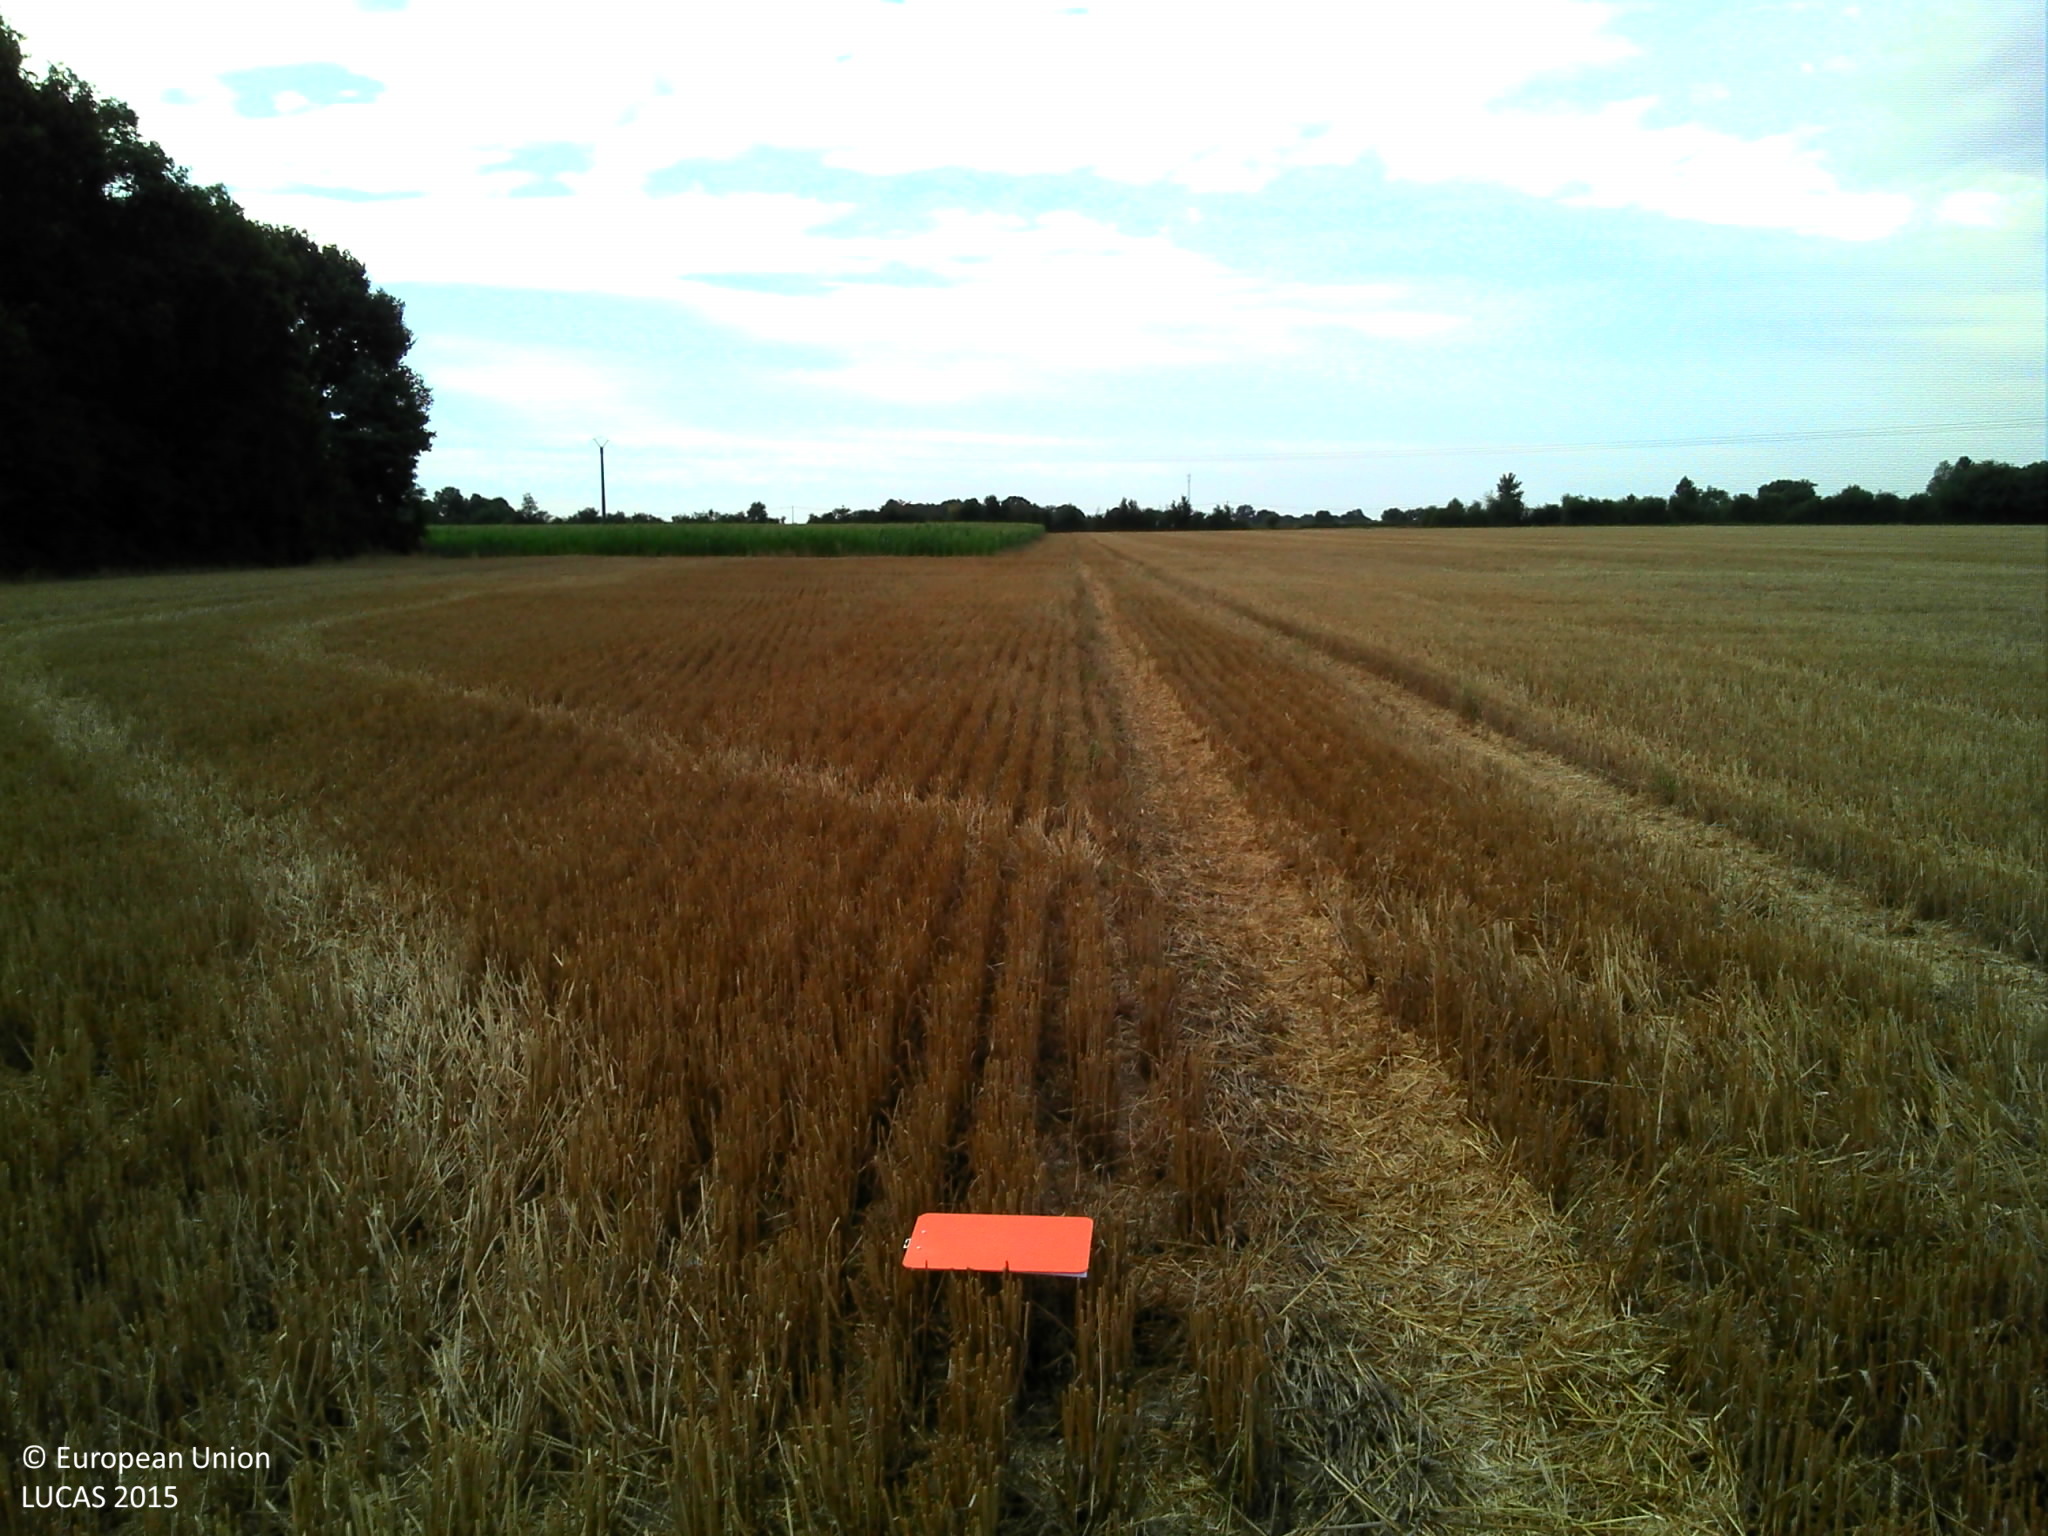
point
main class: Cropland
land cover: Common wheat
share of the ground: > 75 %
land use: Agriculture (excluding fallow land and kitchen gardens)
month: July
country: FR
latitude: 46.4982
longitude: 0.1946
